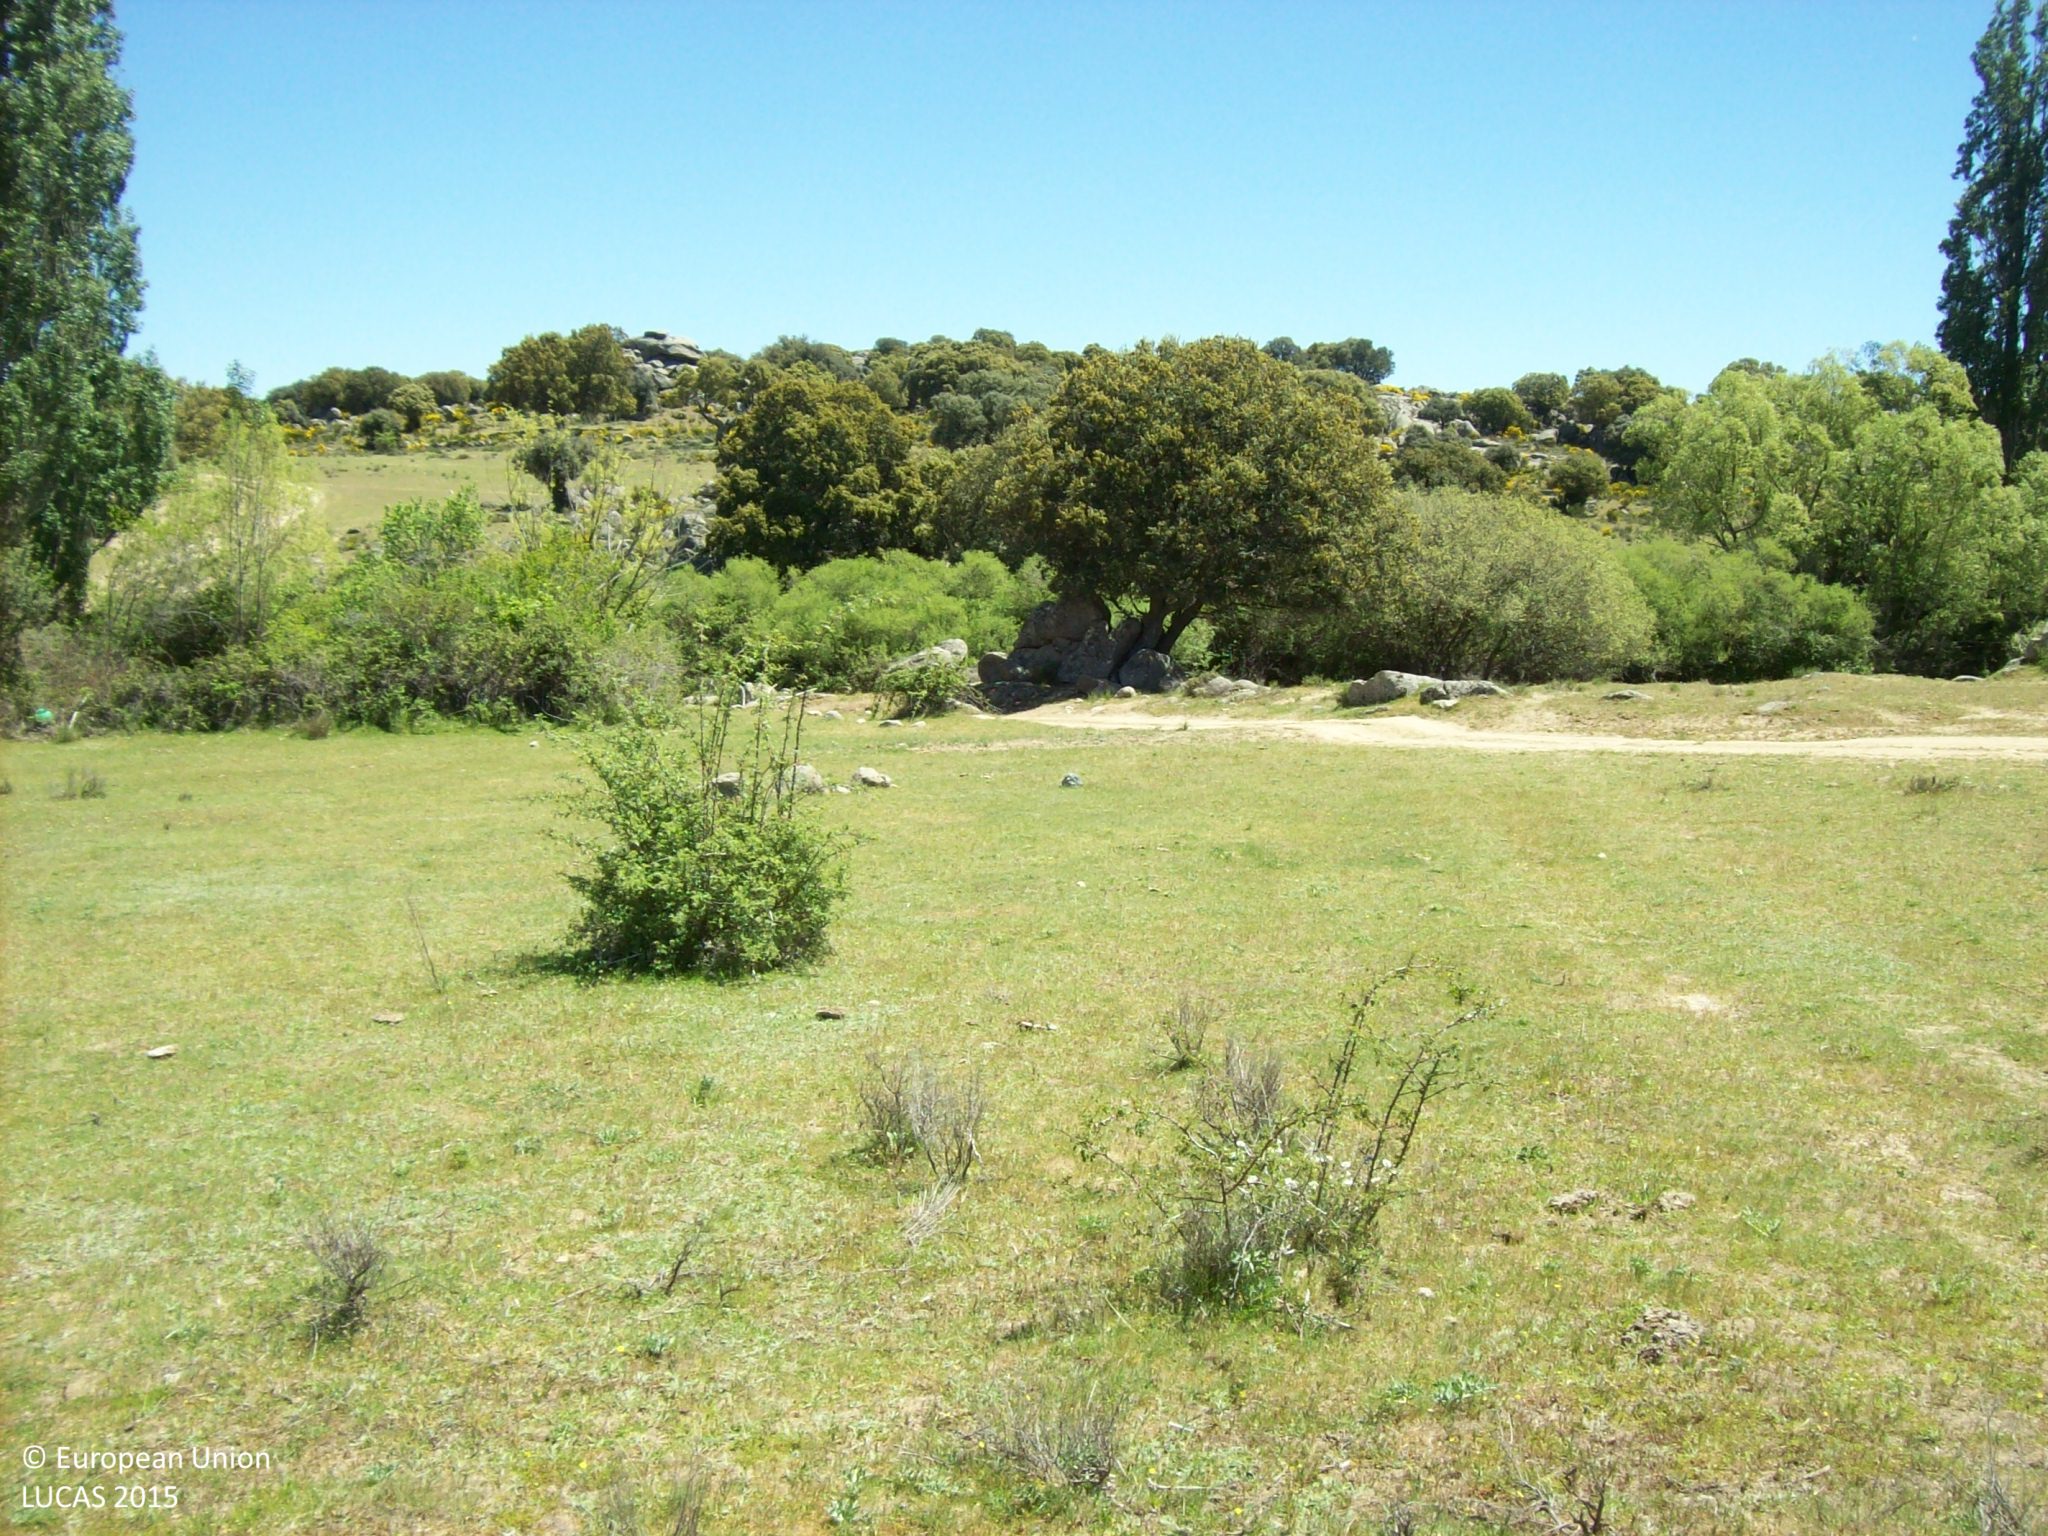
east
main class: Grassland
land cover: Grassland without tree/shrub cover
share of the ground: > 75 %
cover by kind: herbaceous plants 90 %, shrubs 5 %, consolidated bare surface 5 %
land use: Agriculture (excluding fallow land and kitchen gardens)
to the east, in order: Grassland without tree/shrub cover; Tracks; Grassland with sparse tree/shrub cover; Rivers and streams; Broadleaved woodland; Grassland with sparse tree/shrub cover; Dry stone walls; Rock outcrops; Grassland without tree/shrub cover; Tracks; Grassland with sparse tree/shrub cover; Rock outcrops; Broadleaved woodland
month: May
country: ES
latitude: 40.7134
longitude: -4.9399
